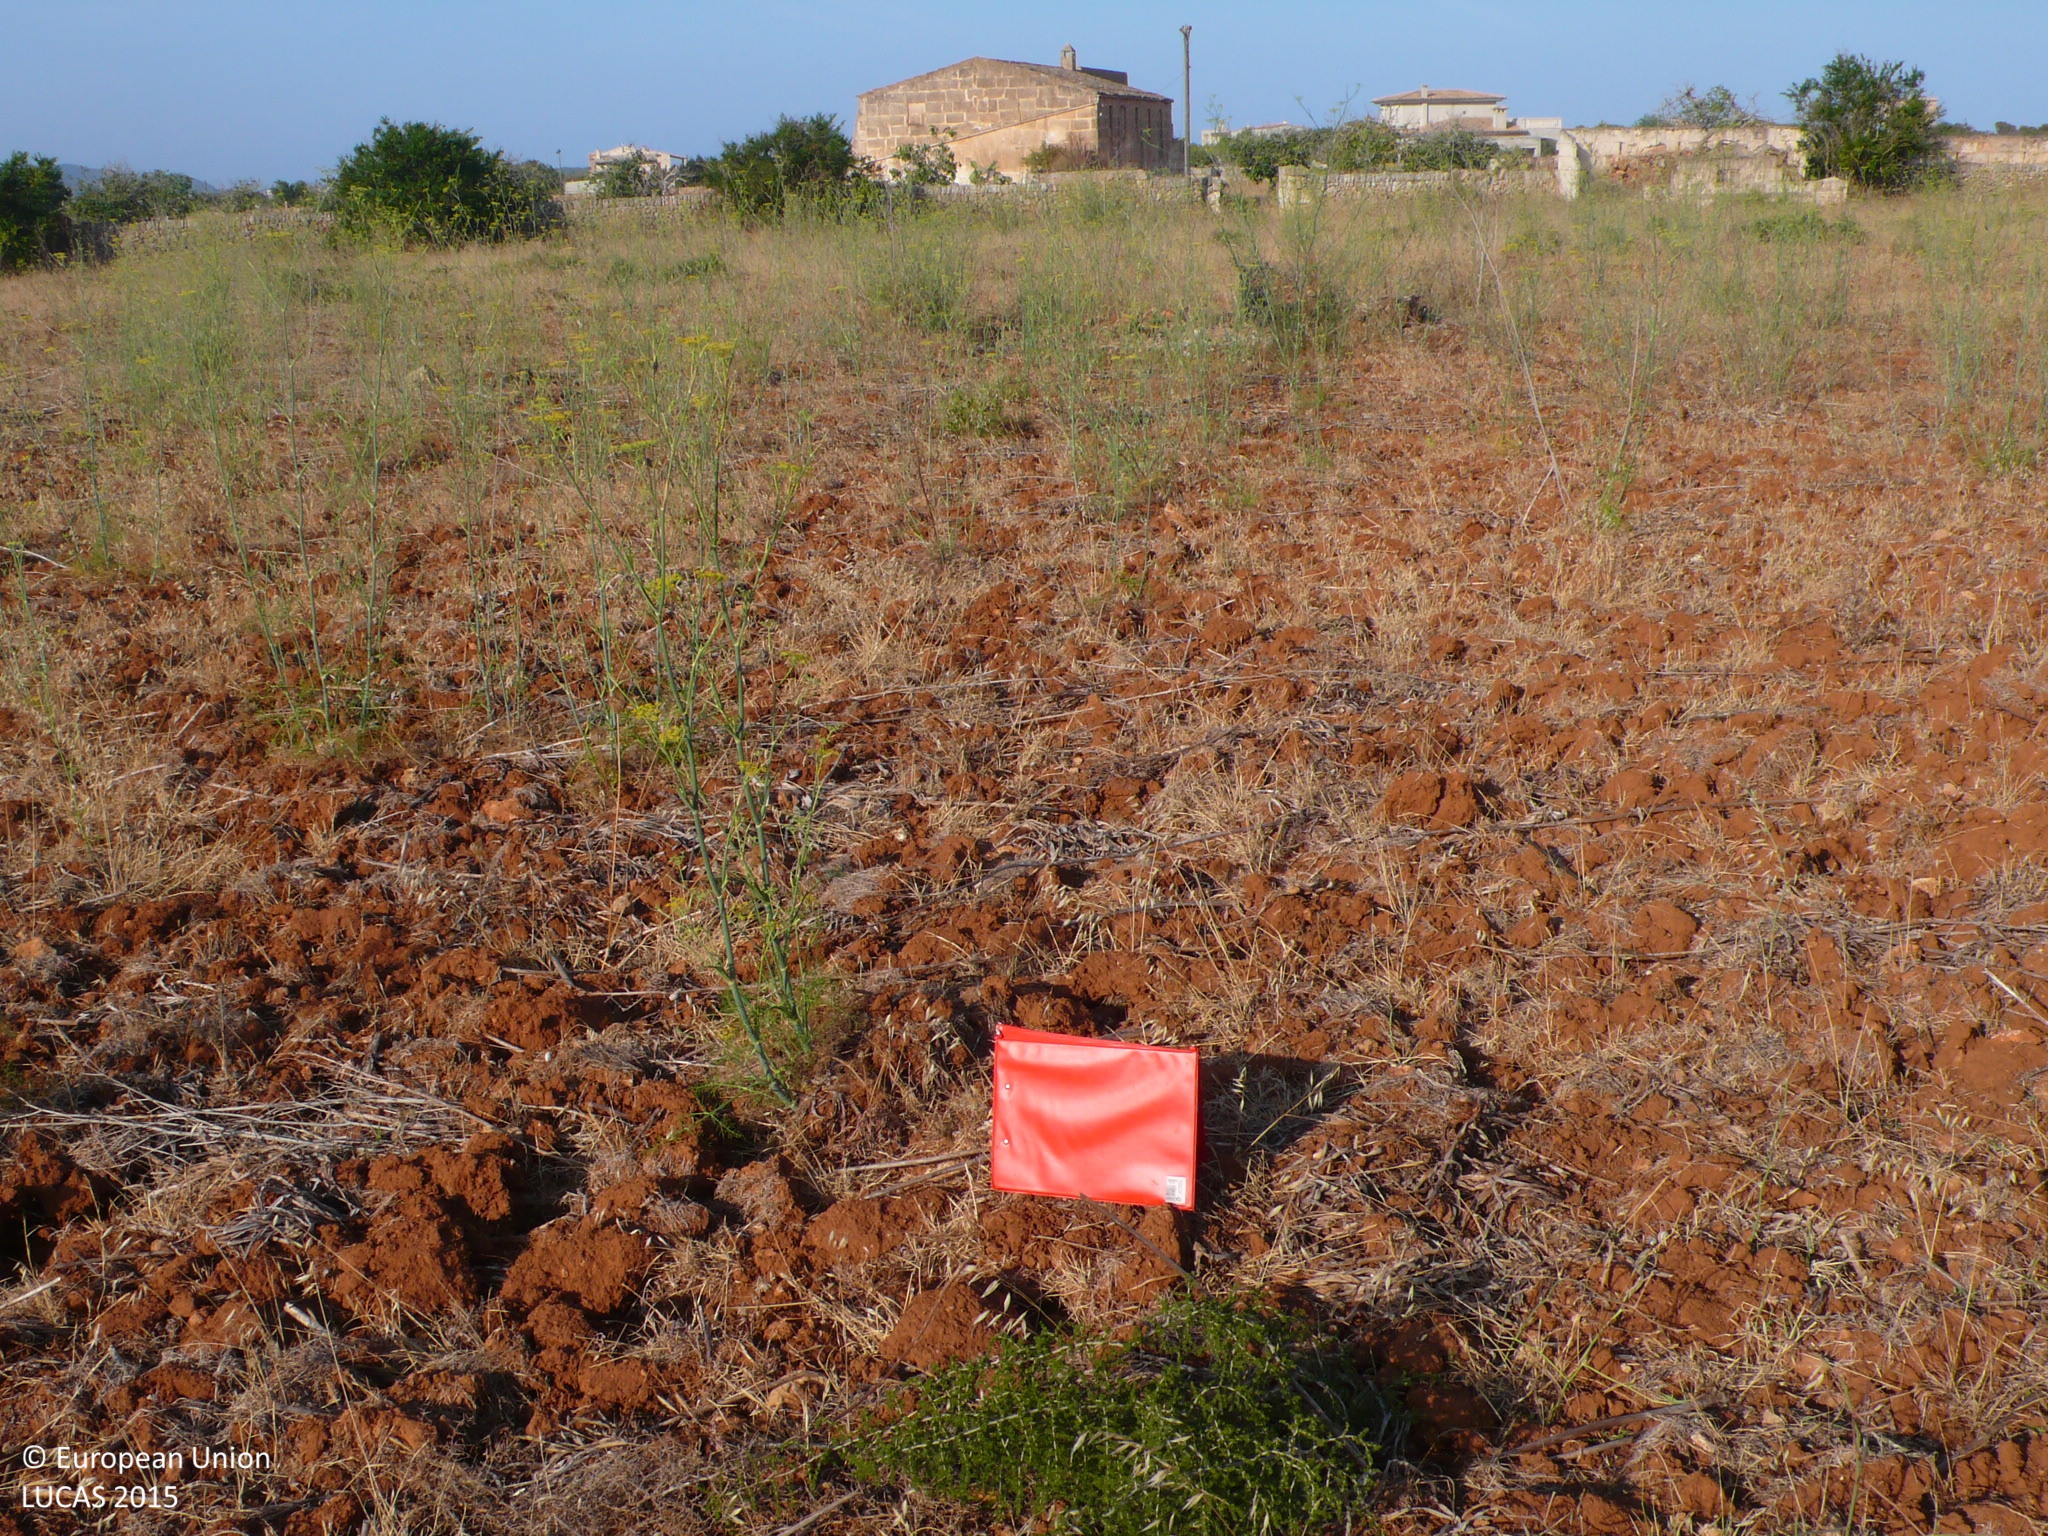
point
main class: Grassland
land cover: Spontaneously vegetated surfaces
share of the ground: 25 - 50 %
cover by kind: unconsolidated bare surface 65 %, herbaceous plants 35 %
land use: Fallow land
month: July
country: ES
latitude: 39.5504
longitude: 3.3384
